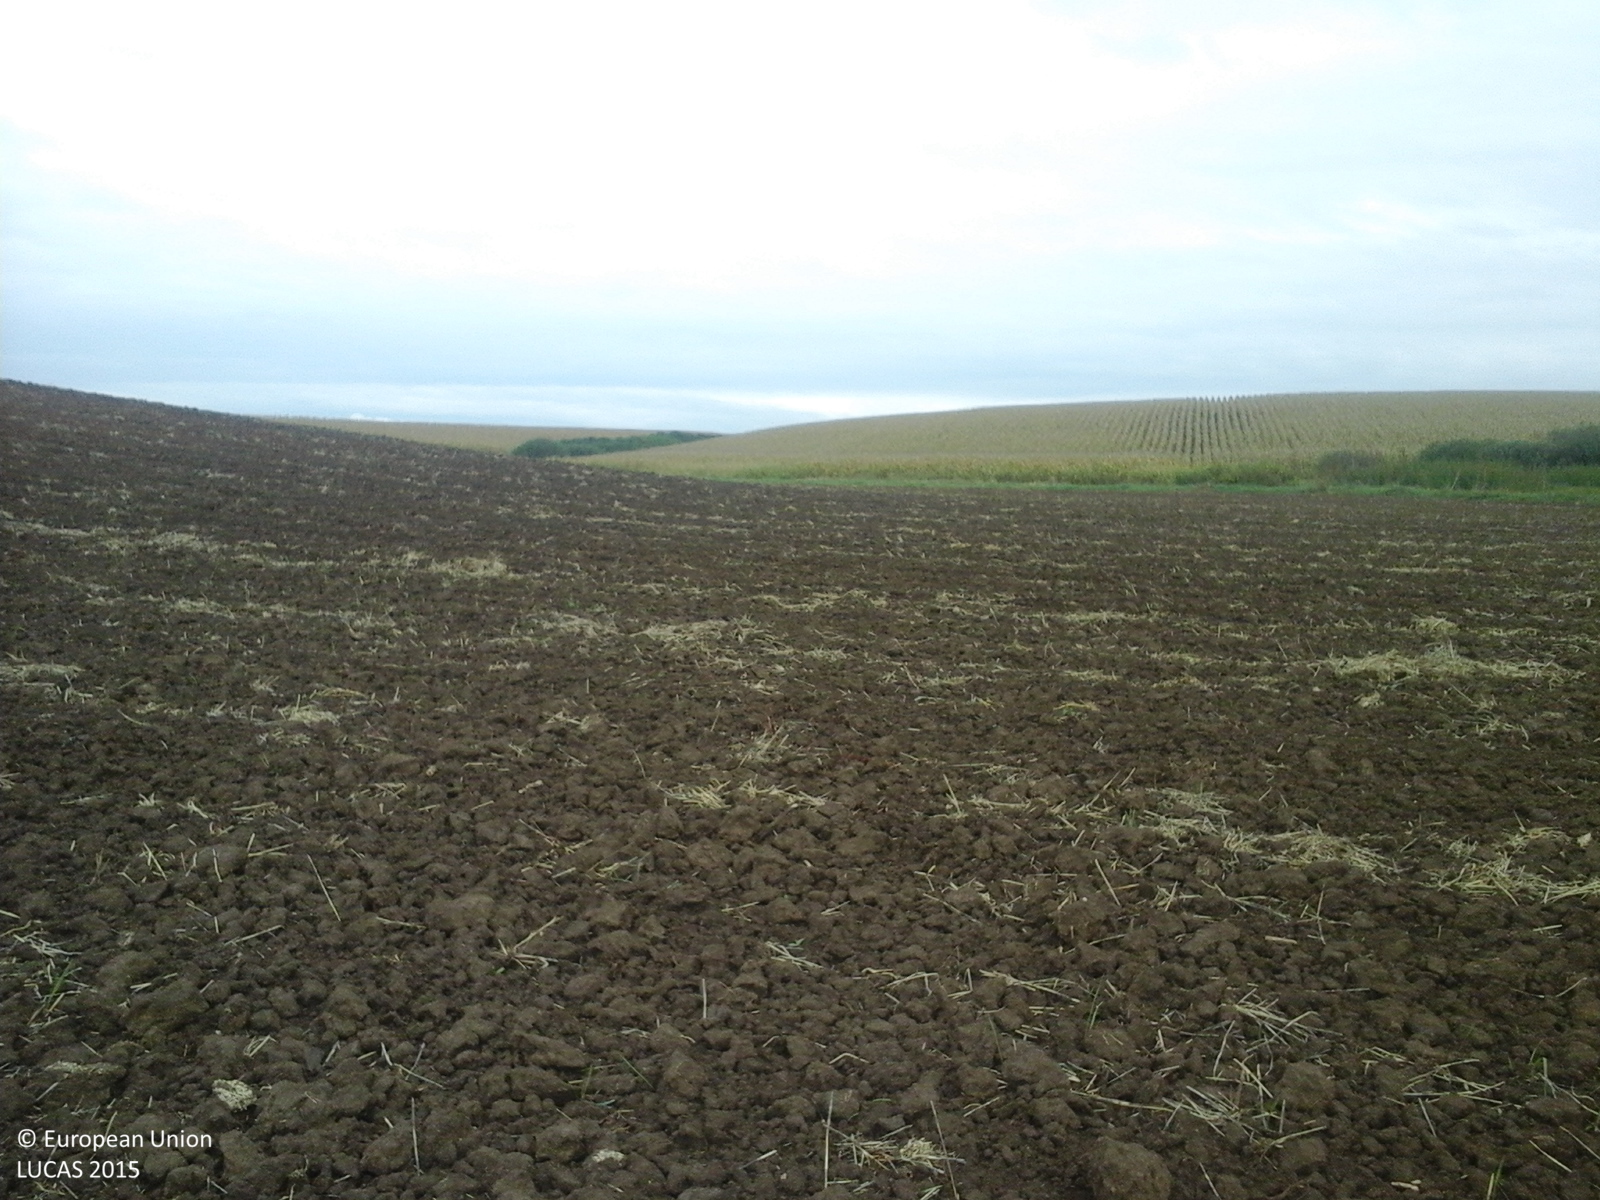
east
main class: Cropland
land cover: Common wheat
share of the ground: < 10 %
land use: Agriculture (excluding fallow land and kitchen gardens)
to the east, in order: Common wheat; Grass margins; Tracks; Grass margins; Maize
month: September
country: RO
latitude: 47.1962
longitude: 22.0470
